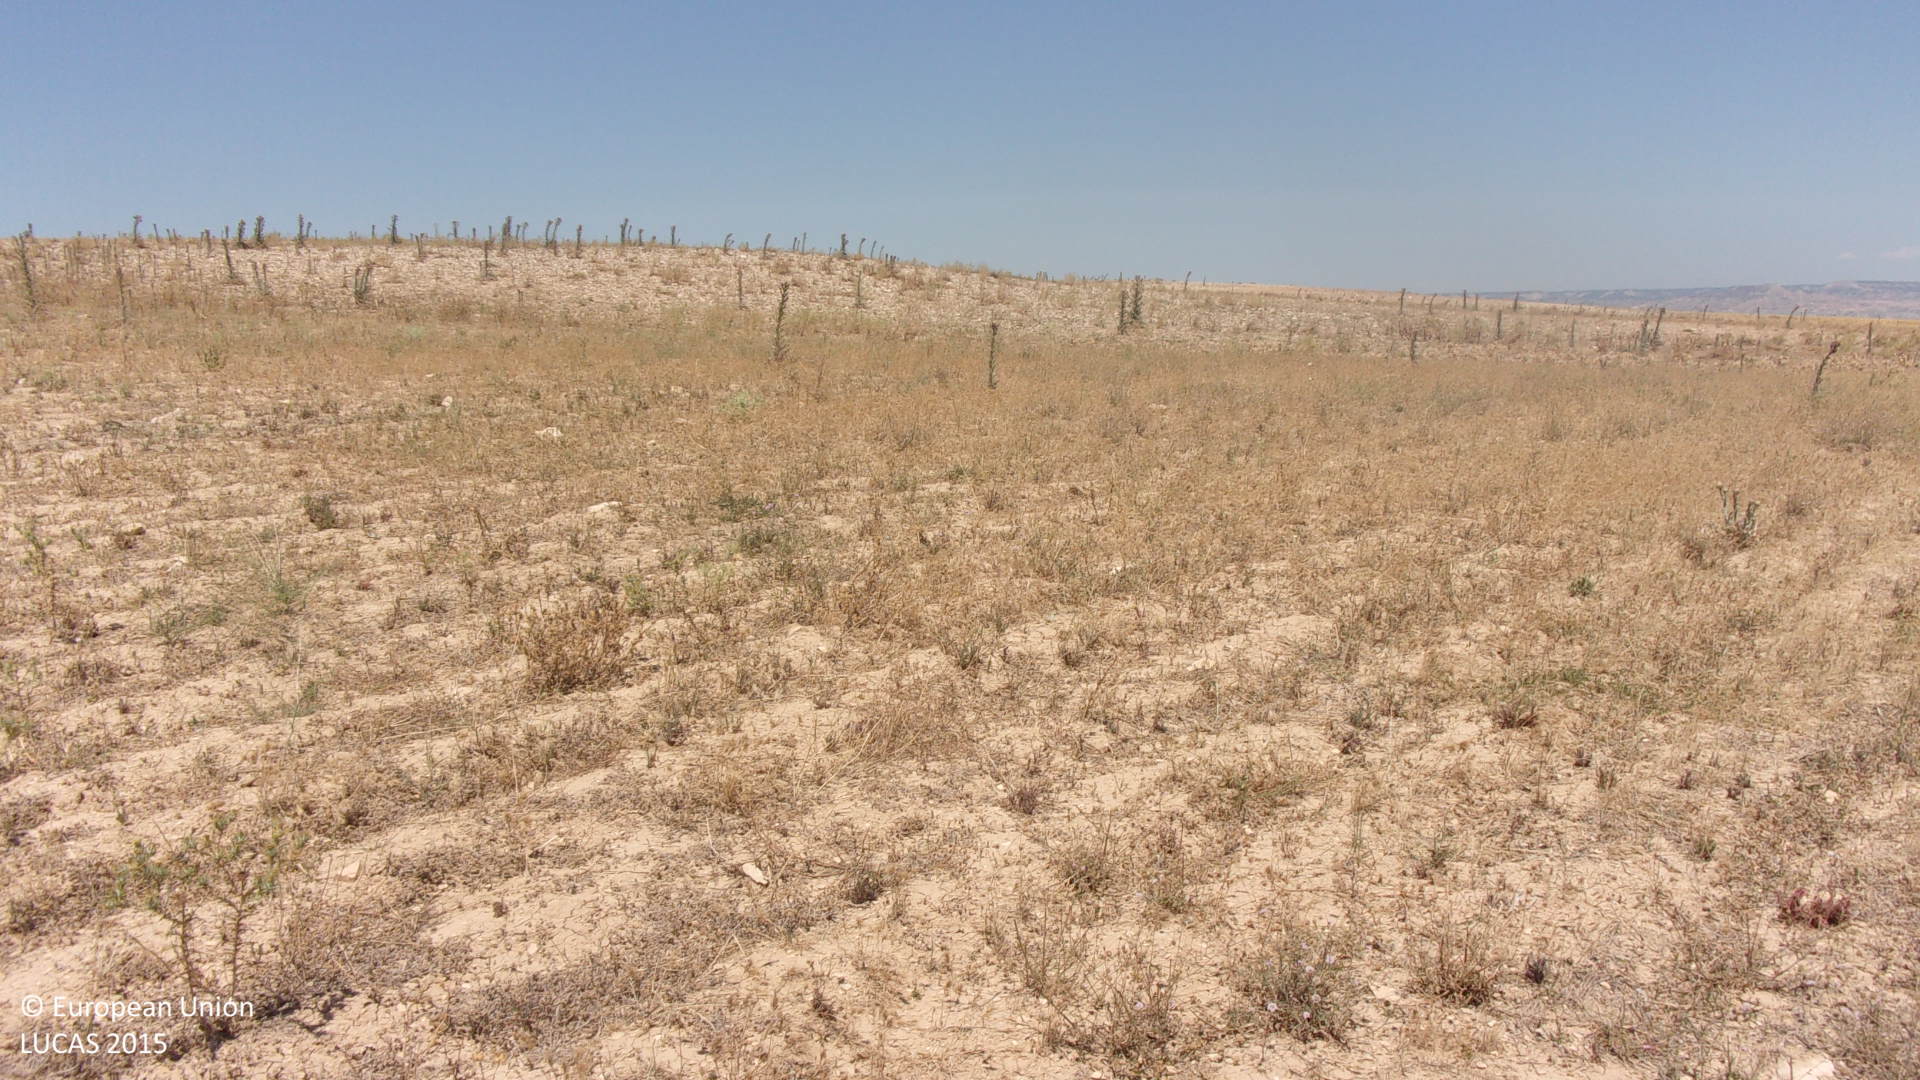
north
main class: Grassland
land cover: Spontaneously vegetated surfaces
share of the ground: 25 - 50 %
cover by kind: unconsolidated bare surface 65 %, herbaceous plants 35 %
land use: Fallow land
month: July
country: ES
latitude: 41.8885
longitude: -1.4904
